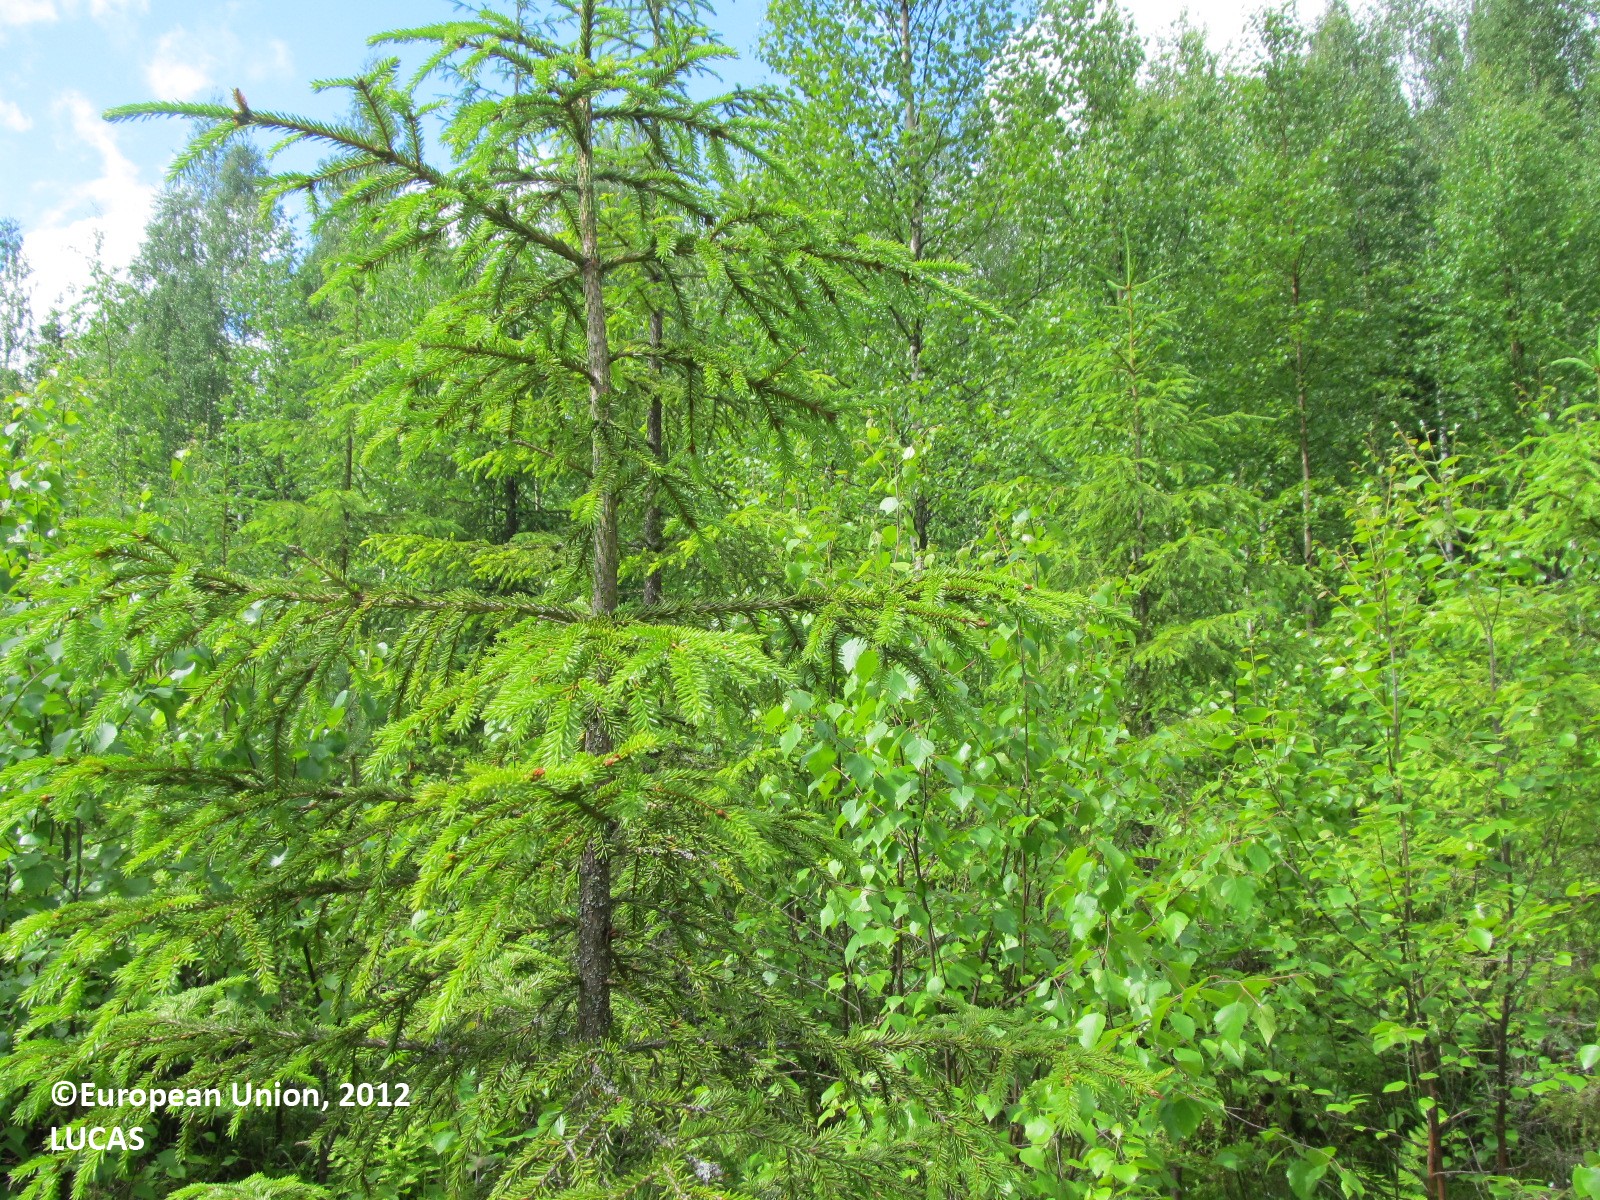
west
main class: Woodland
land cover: Spruce dominated mixed woodland
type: boreal forest
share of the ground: 50 - 75 %
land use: Forestry
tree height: < 5 m
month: June
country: FI
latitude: 62.9956
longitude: 28.9458
